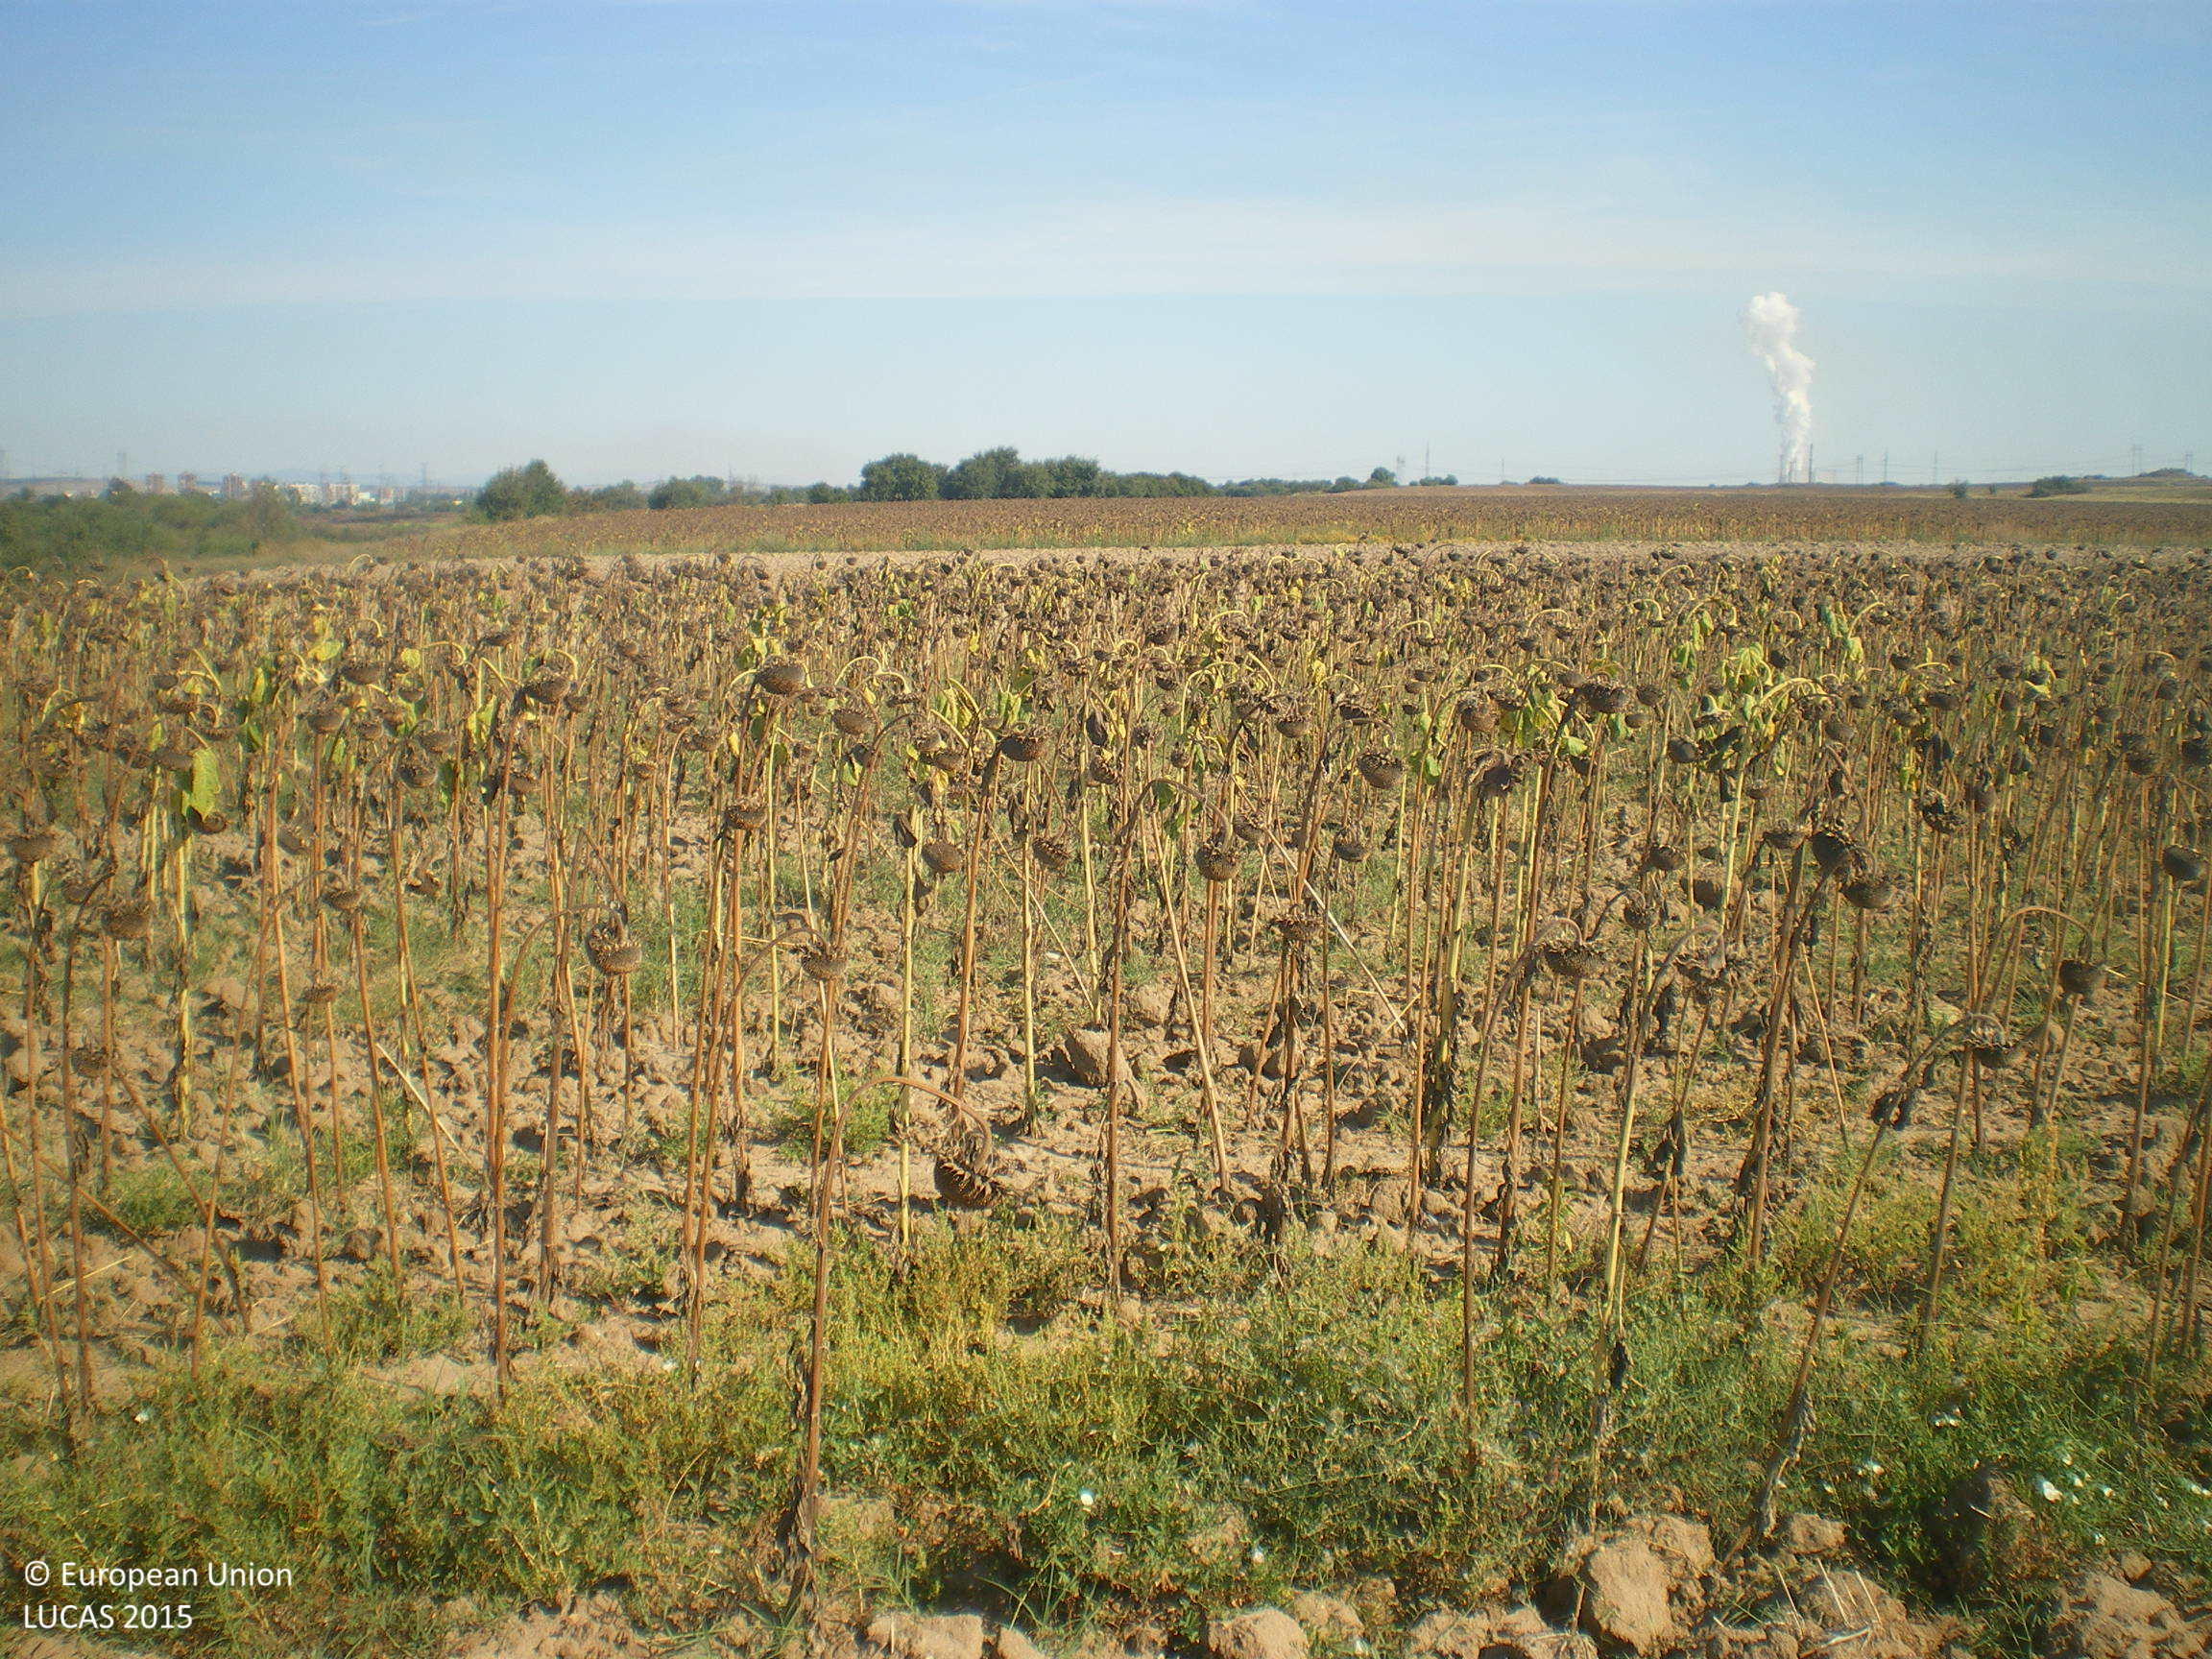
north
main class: Cropland
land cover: Common wheat
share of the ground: < 10 %
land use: Agriculture (excluding fallow land and kitchen gardens)
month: September
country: BG
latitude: 42.1085
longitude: 25.8792
